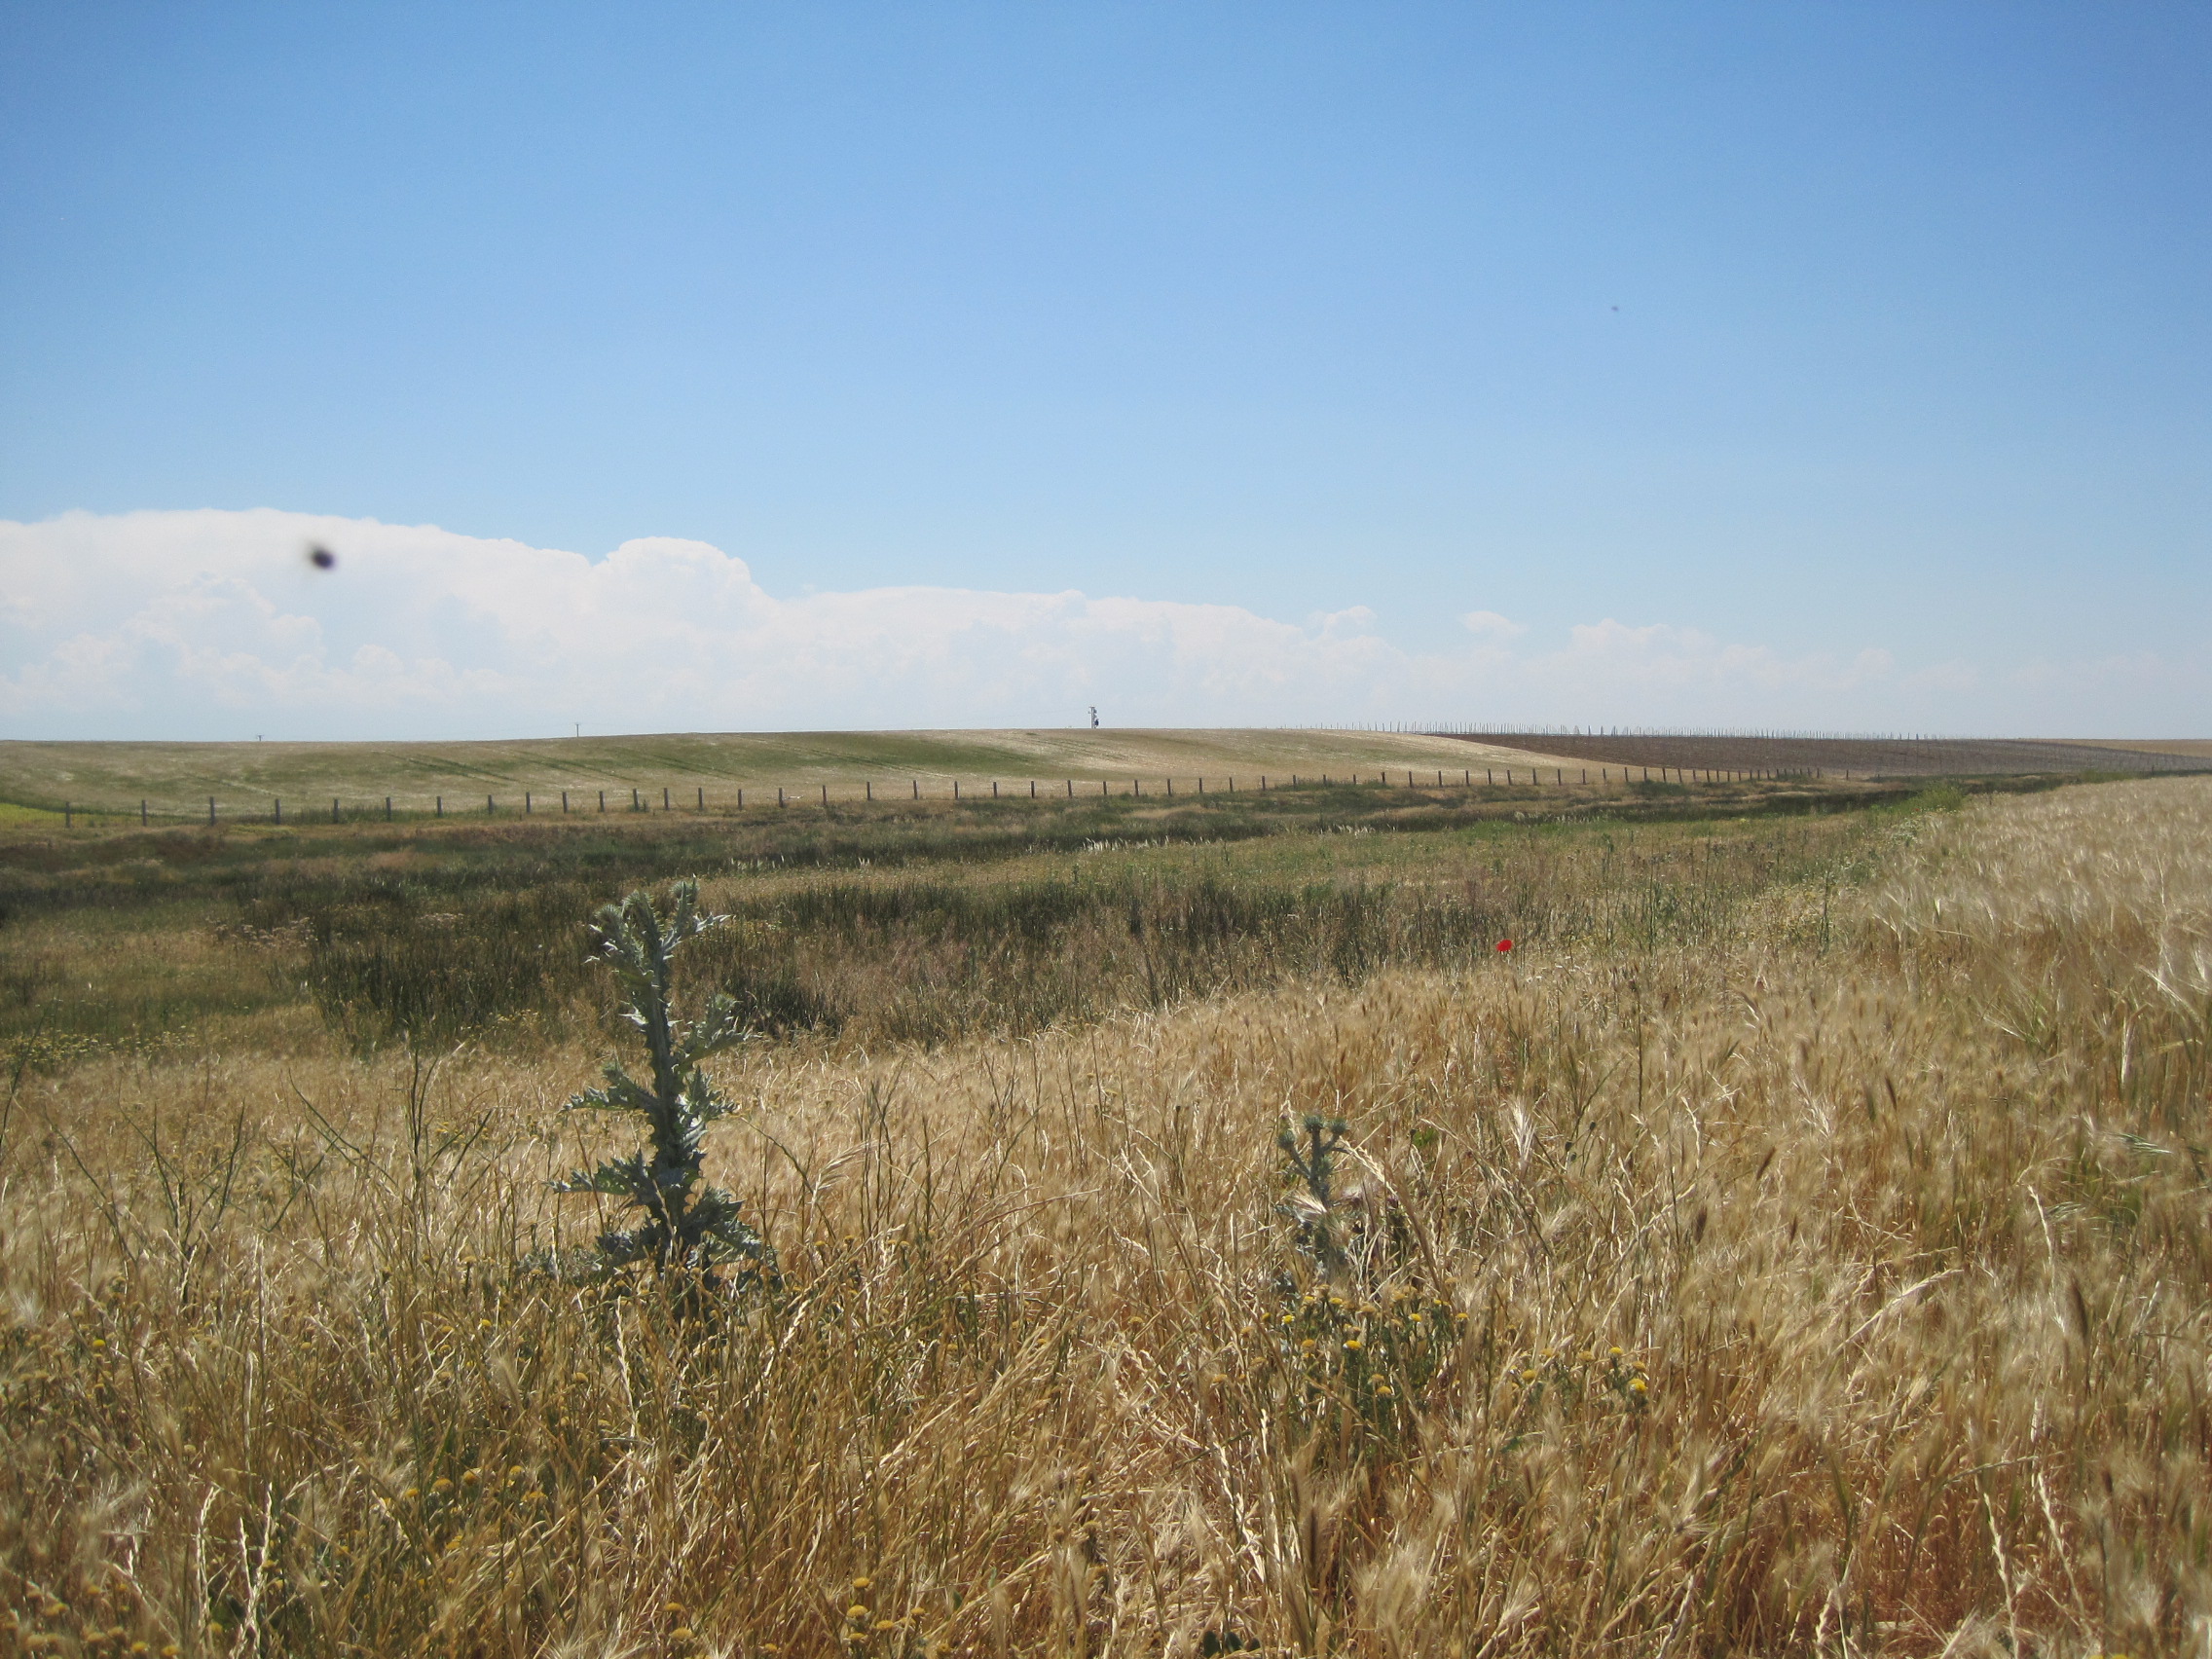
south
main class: Grassland
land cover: Spontaneously vegetated surfaces
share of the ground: > 75 %
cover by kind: herbaceous plants 100 %
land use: Semi-natural and natural areas not in use
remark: Temporary dry
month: May
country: ES
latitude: 41.2829
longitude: -5.0545
